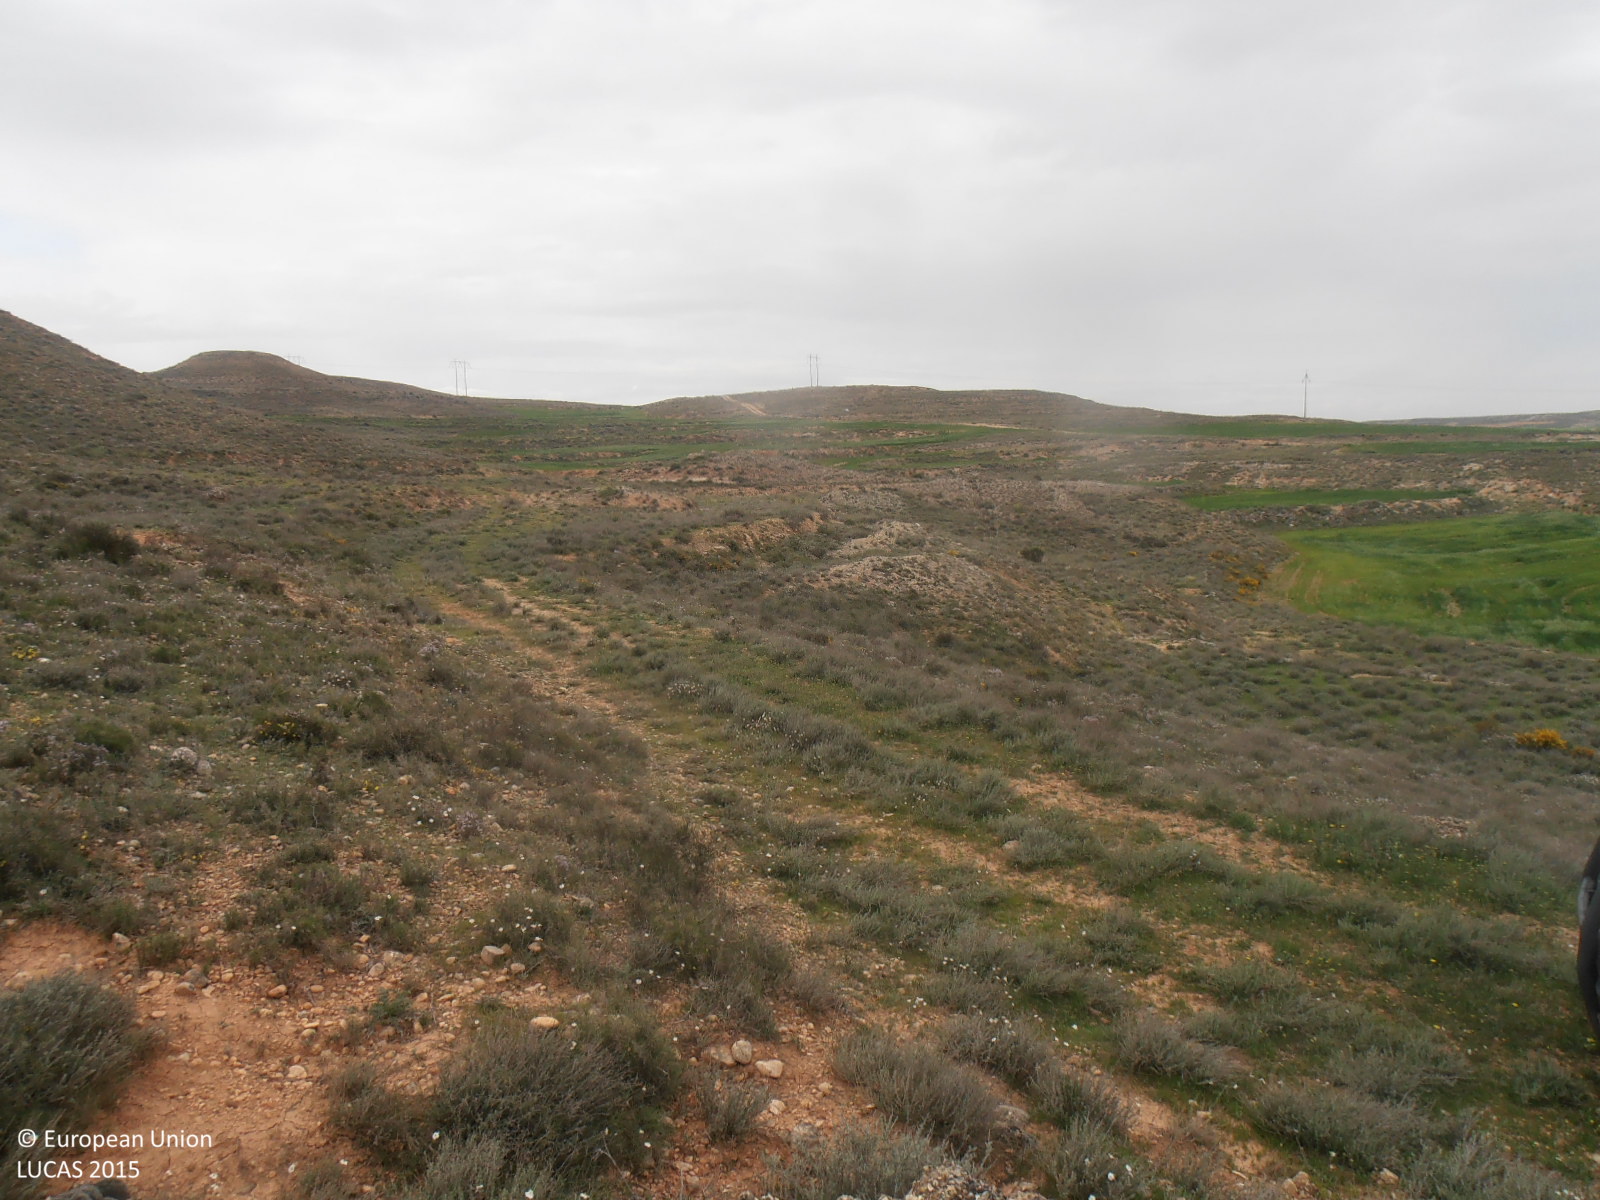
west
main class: Shrubland
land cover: Shrubland without tree cover
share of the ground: > 75 %
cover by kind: shrubs 70 %, herbaceous plants 15 %, consolidated bare surface 15 %
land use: Semi-natural and natural areas not in use
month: April
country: ES
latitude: 41.2273
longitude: -0.3812
